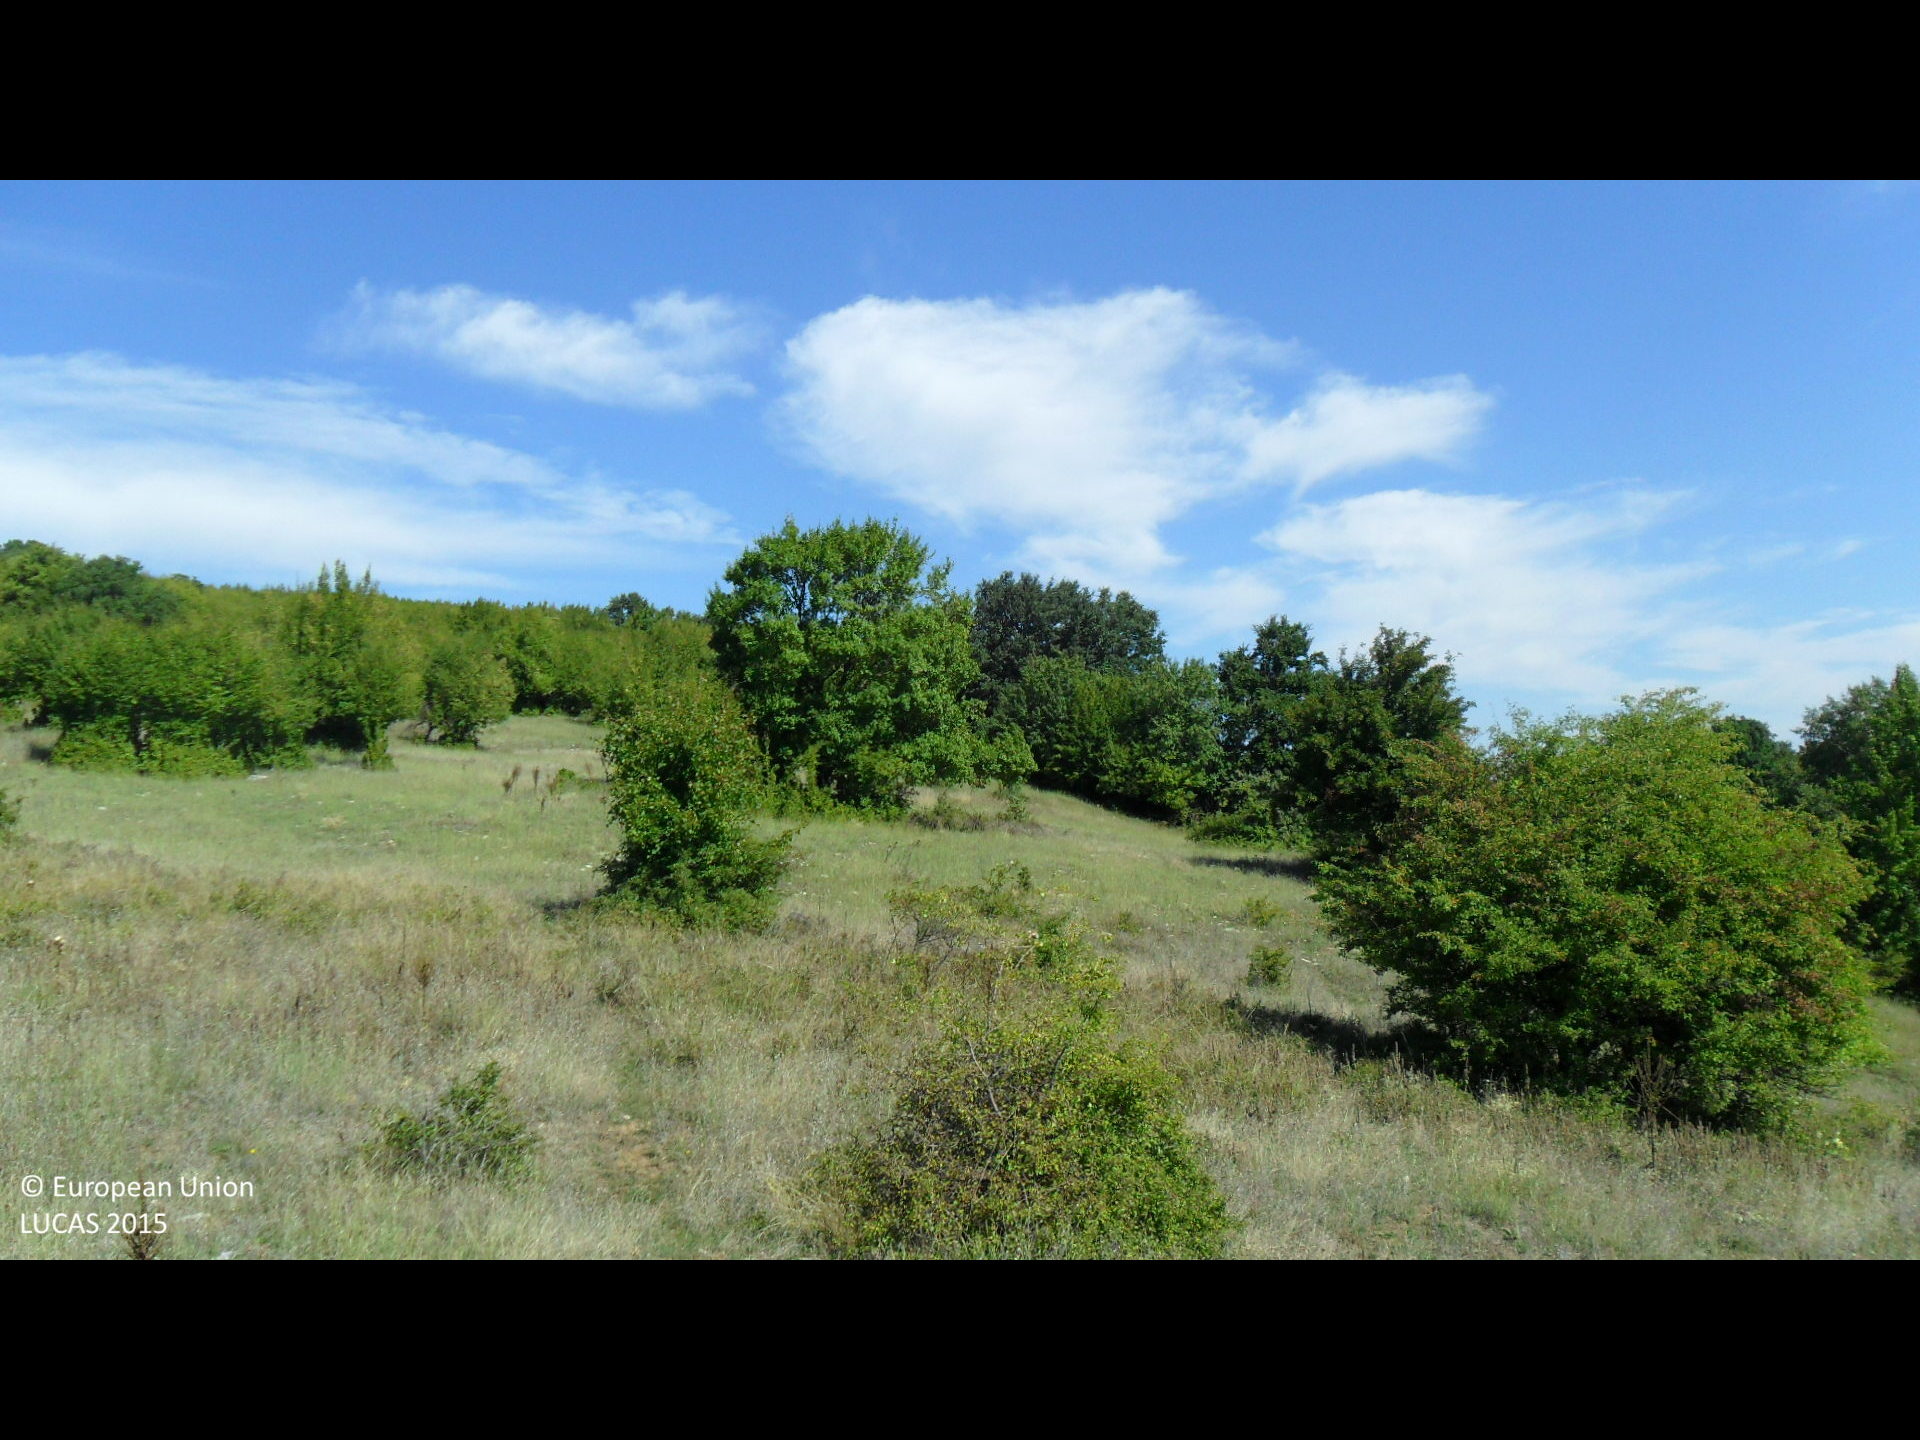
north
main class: Grassland
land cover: Grassland with sparse tree/shrub cover
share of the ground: > 75 %
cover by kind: herbaceous plants 90 %, broadleaved forest trees 5 %, shrubs 5 %
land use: Agriculture (excluding fallow land and kitchen gardens)
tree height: > 5 m
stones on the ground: 25 - 50 %
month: September
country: BG
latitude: 43.2053
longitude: 26.4824
